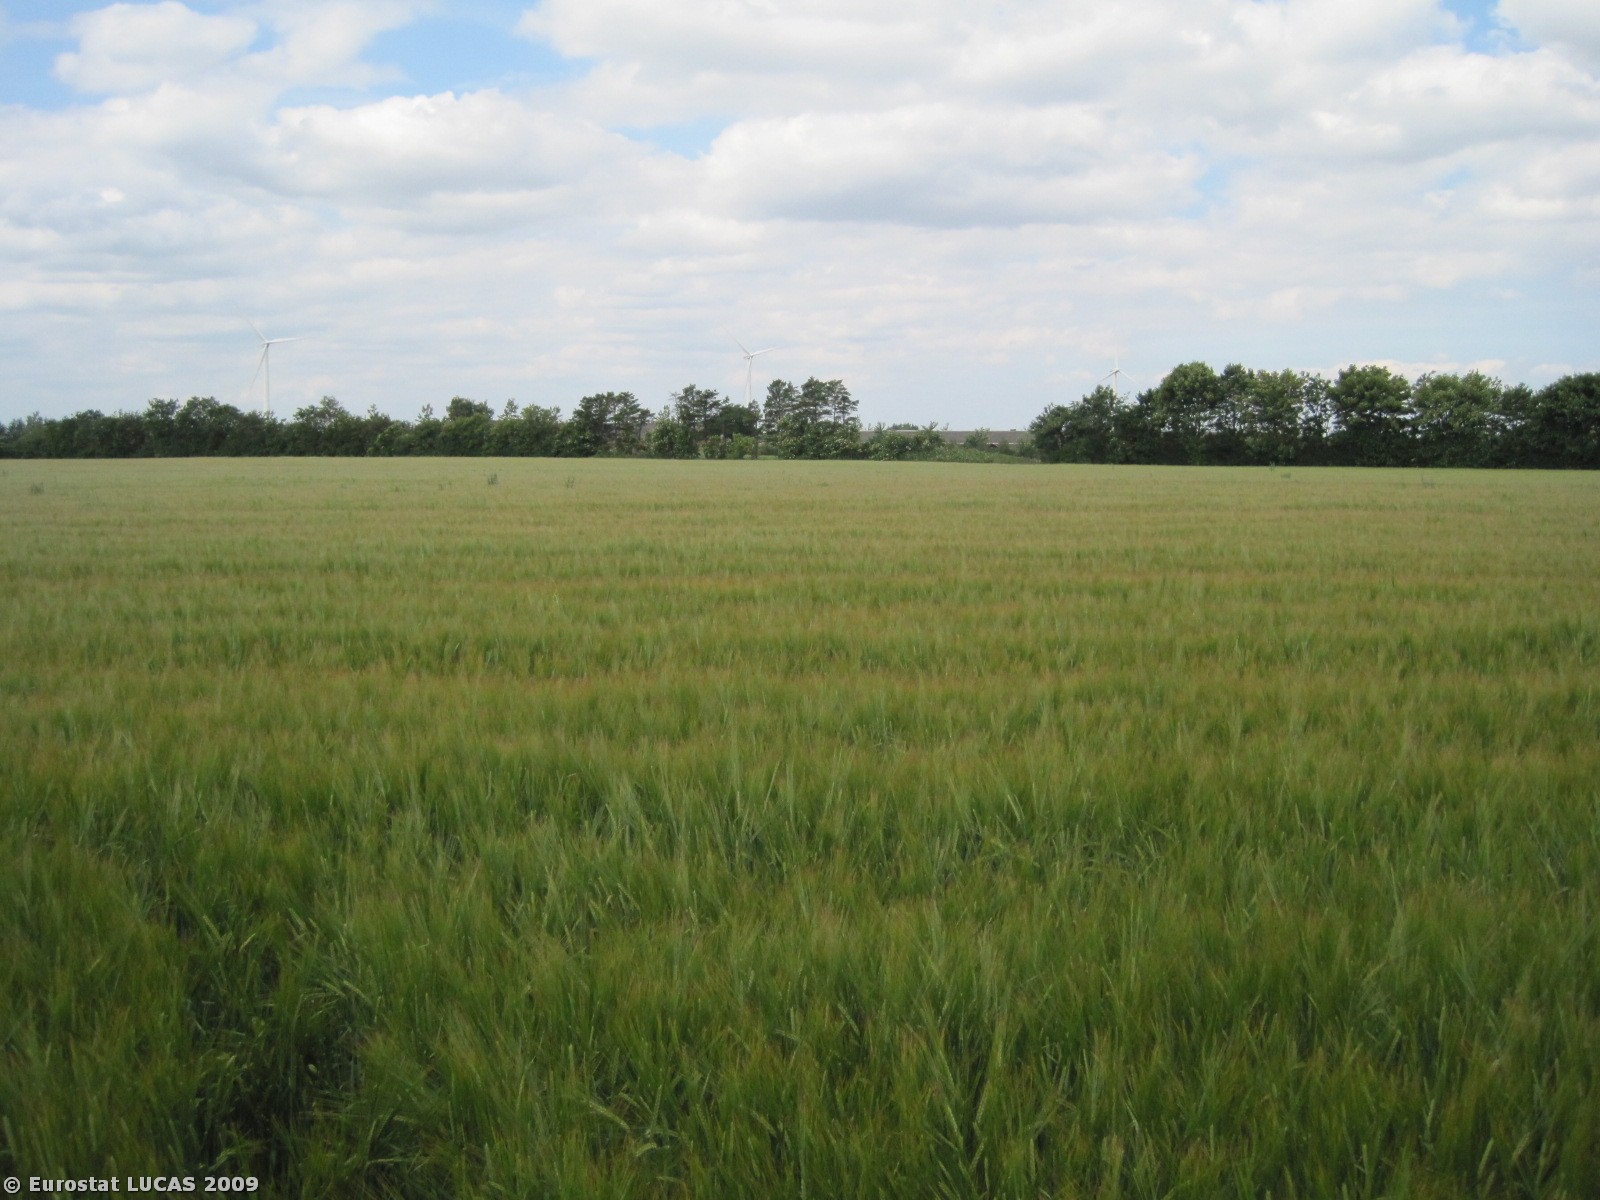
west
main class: Cropland
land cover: Barley
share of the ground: > 75 %
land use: Agriculture (excluding fallow land and kitchen gardens)
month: June
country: DK
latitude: 56.3441
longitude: 8.8204
